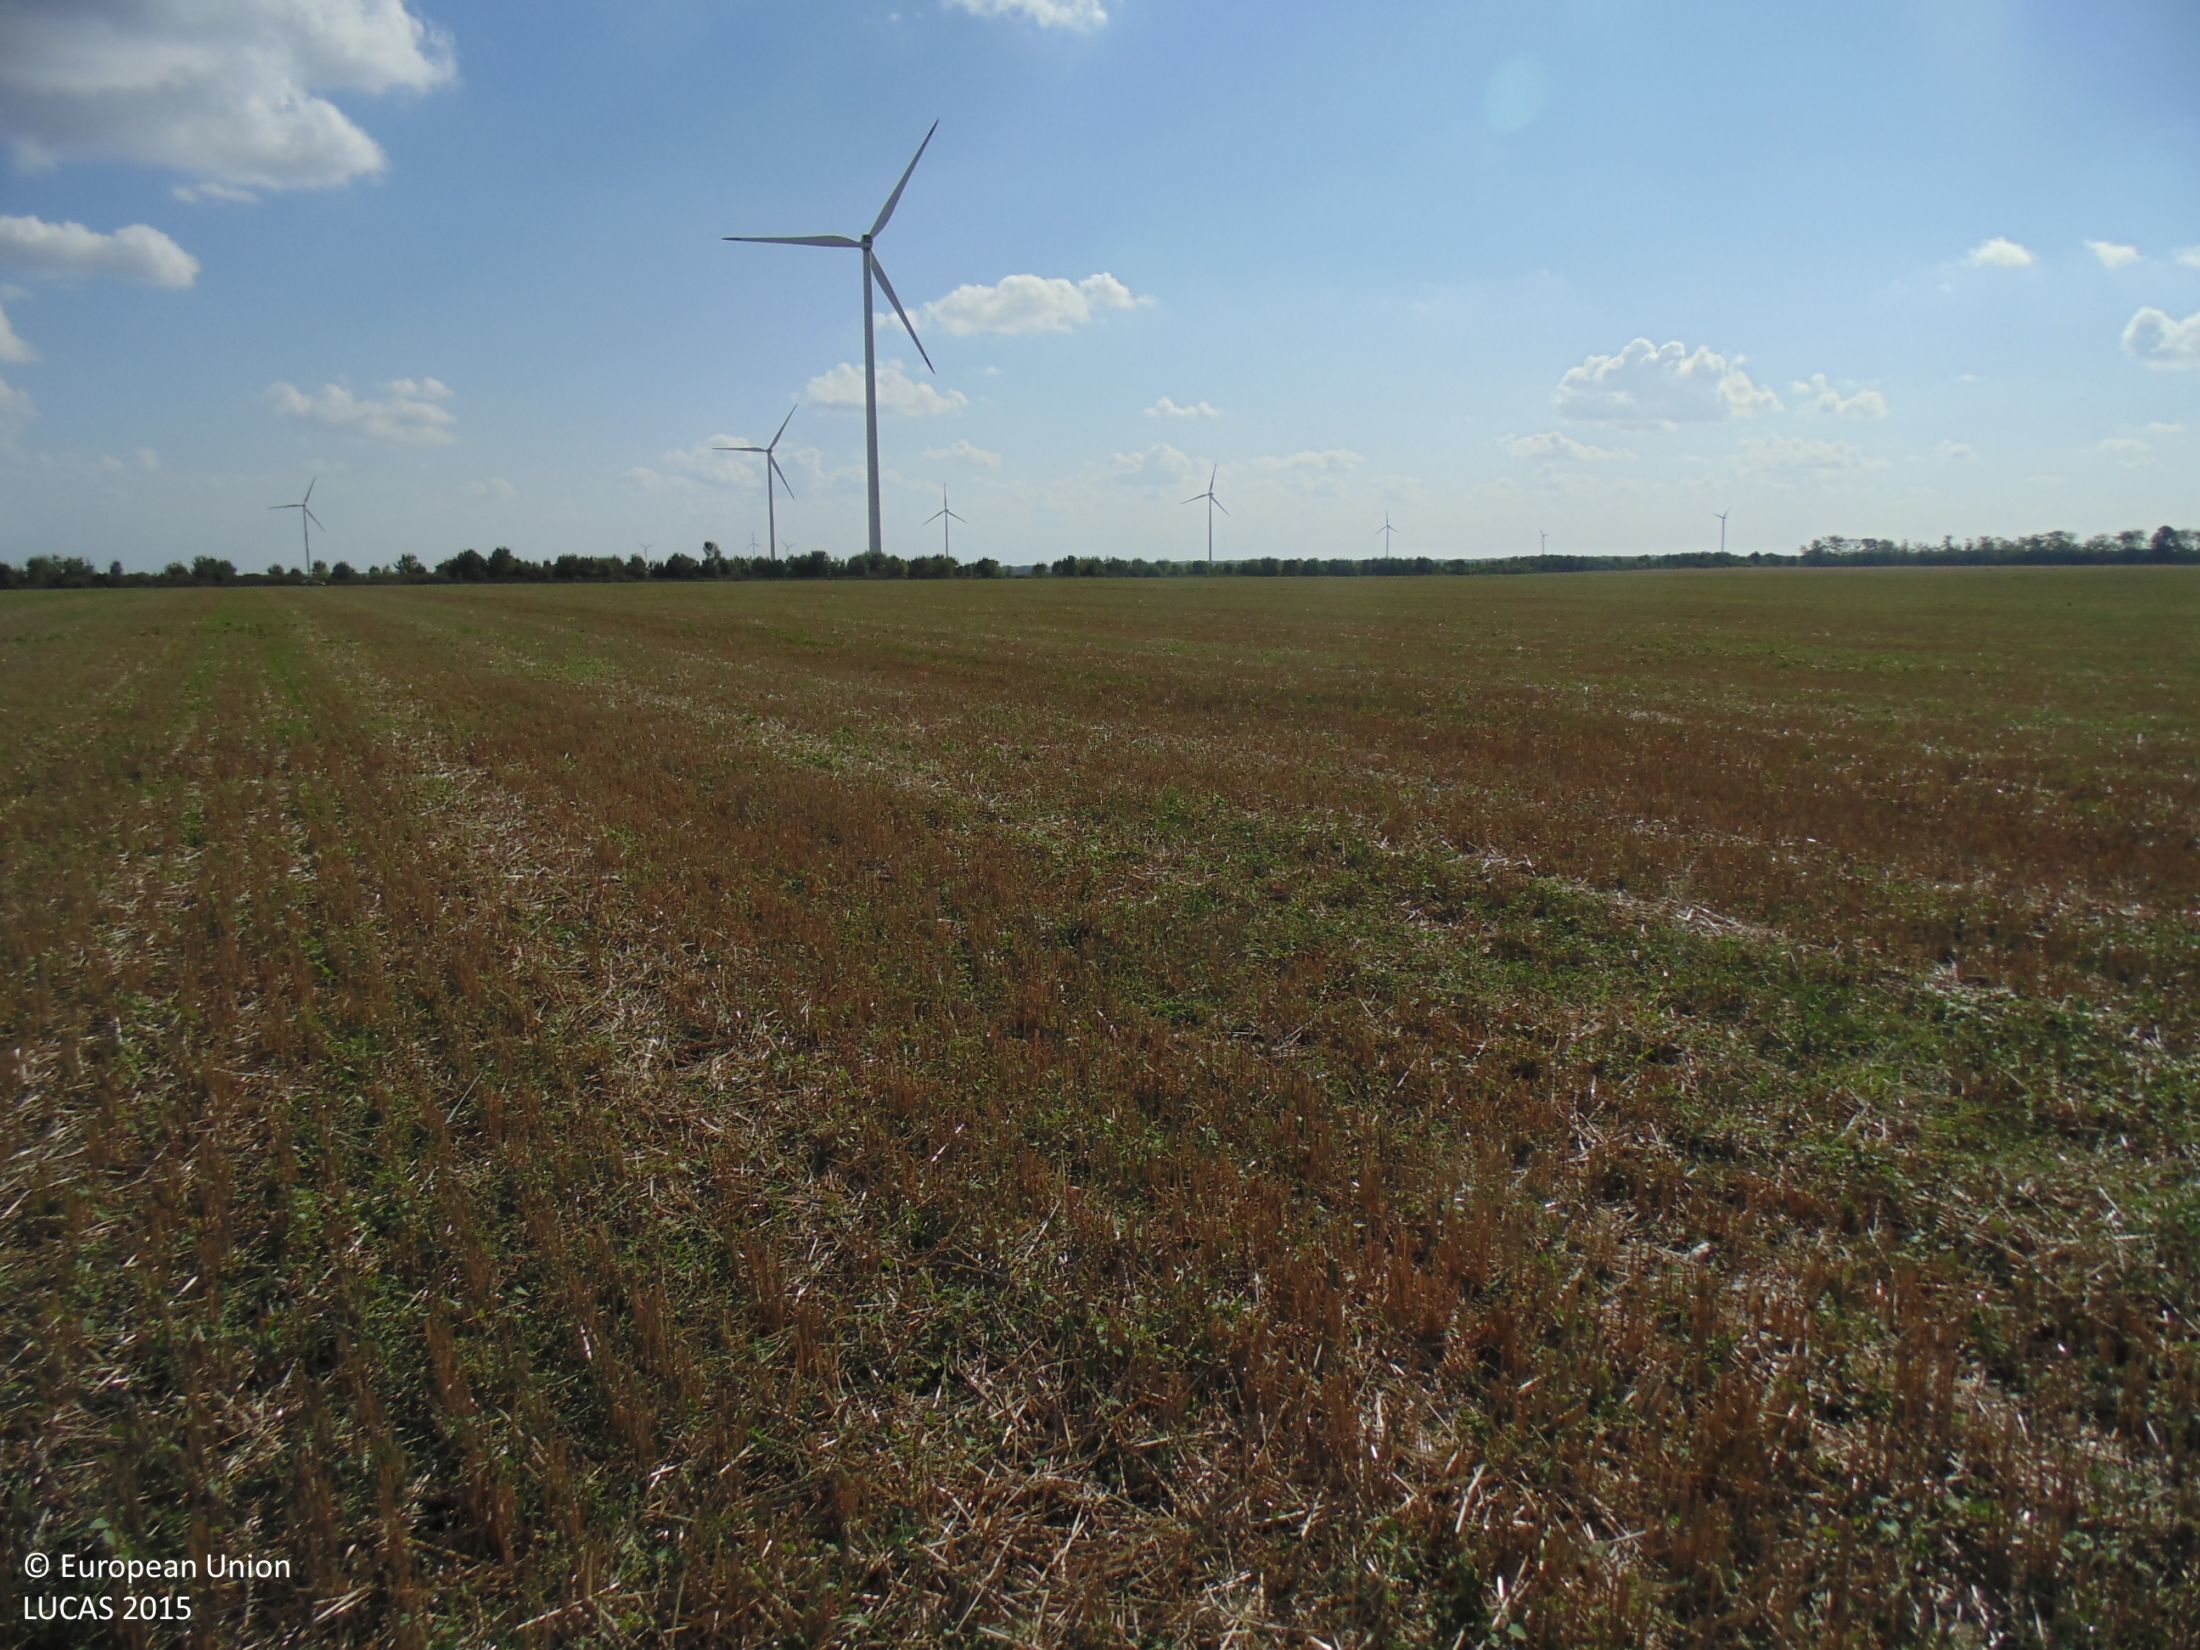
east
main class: Cropland
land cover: Common wheat
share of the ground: 25 - 50 %
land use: Agriculture (excluding fallow land and kitchen gardens)
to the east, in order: Common wheat
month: September
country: BG
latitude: 43.4694
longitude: 28.4665
